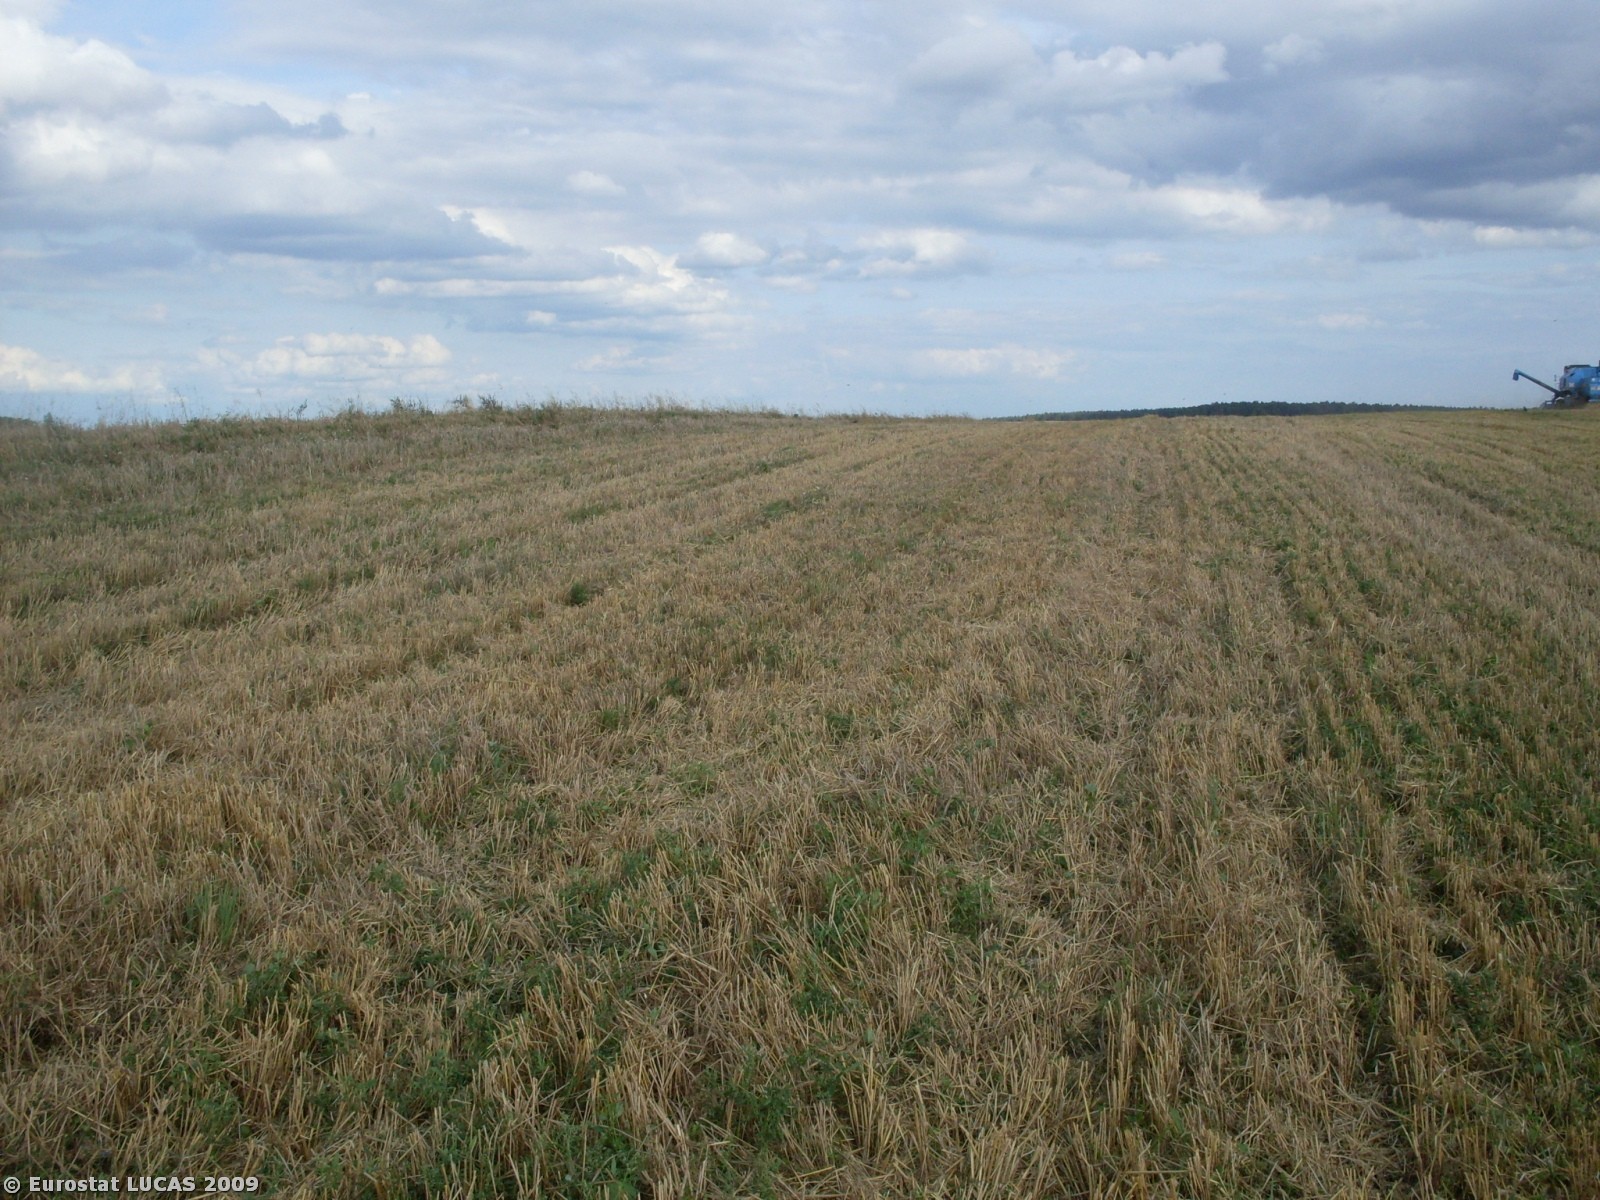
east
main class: Cropland
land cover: Barley
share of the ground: < 10 %
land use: Agriculture (excluding fallow land and kitchen gardens)
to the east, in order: Barley; Oats
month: August
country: PL
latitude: 52.9377
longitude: 15.4344
